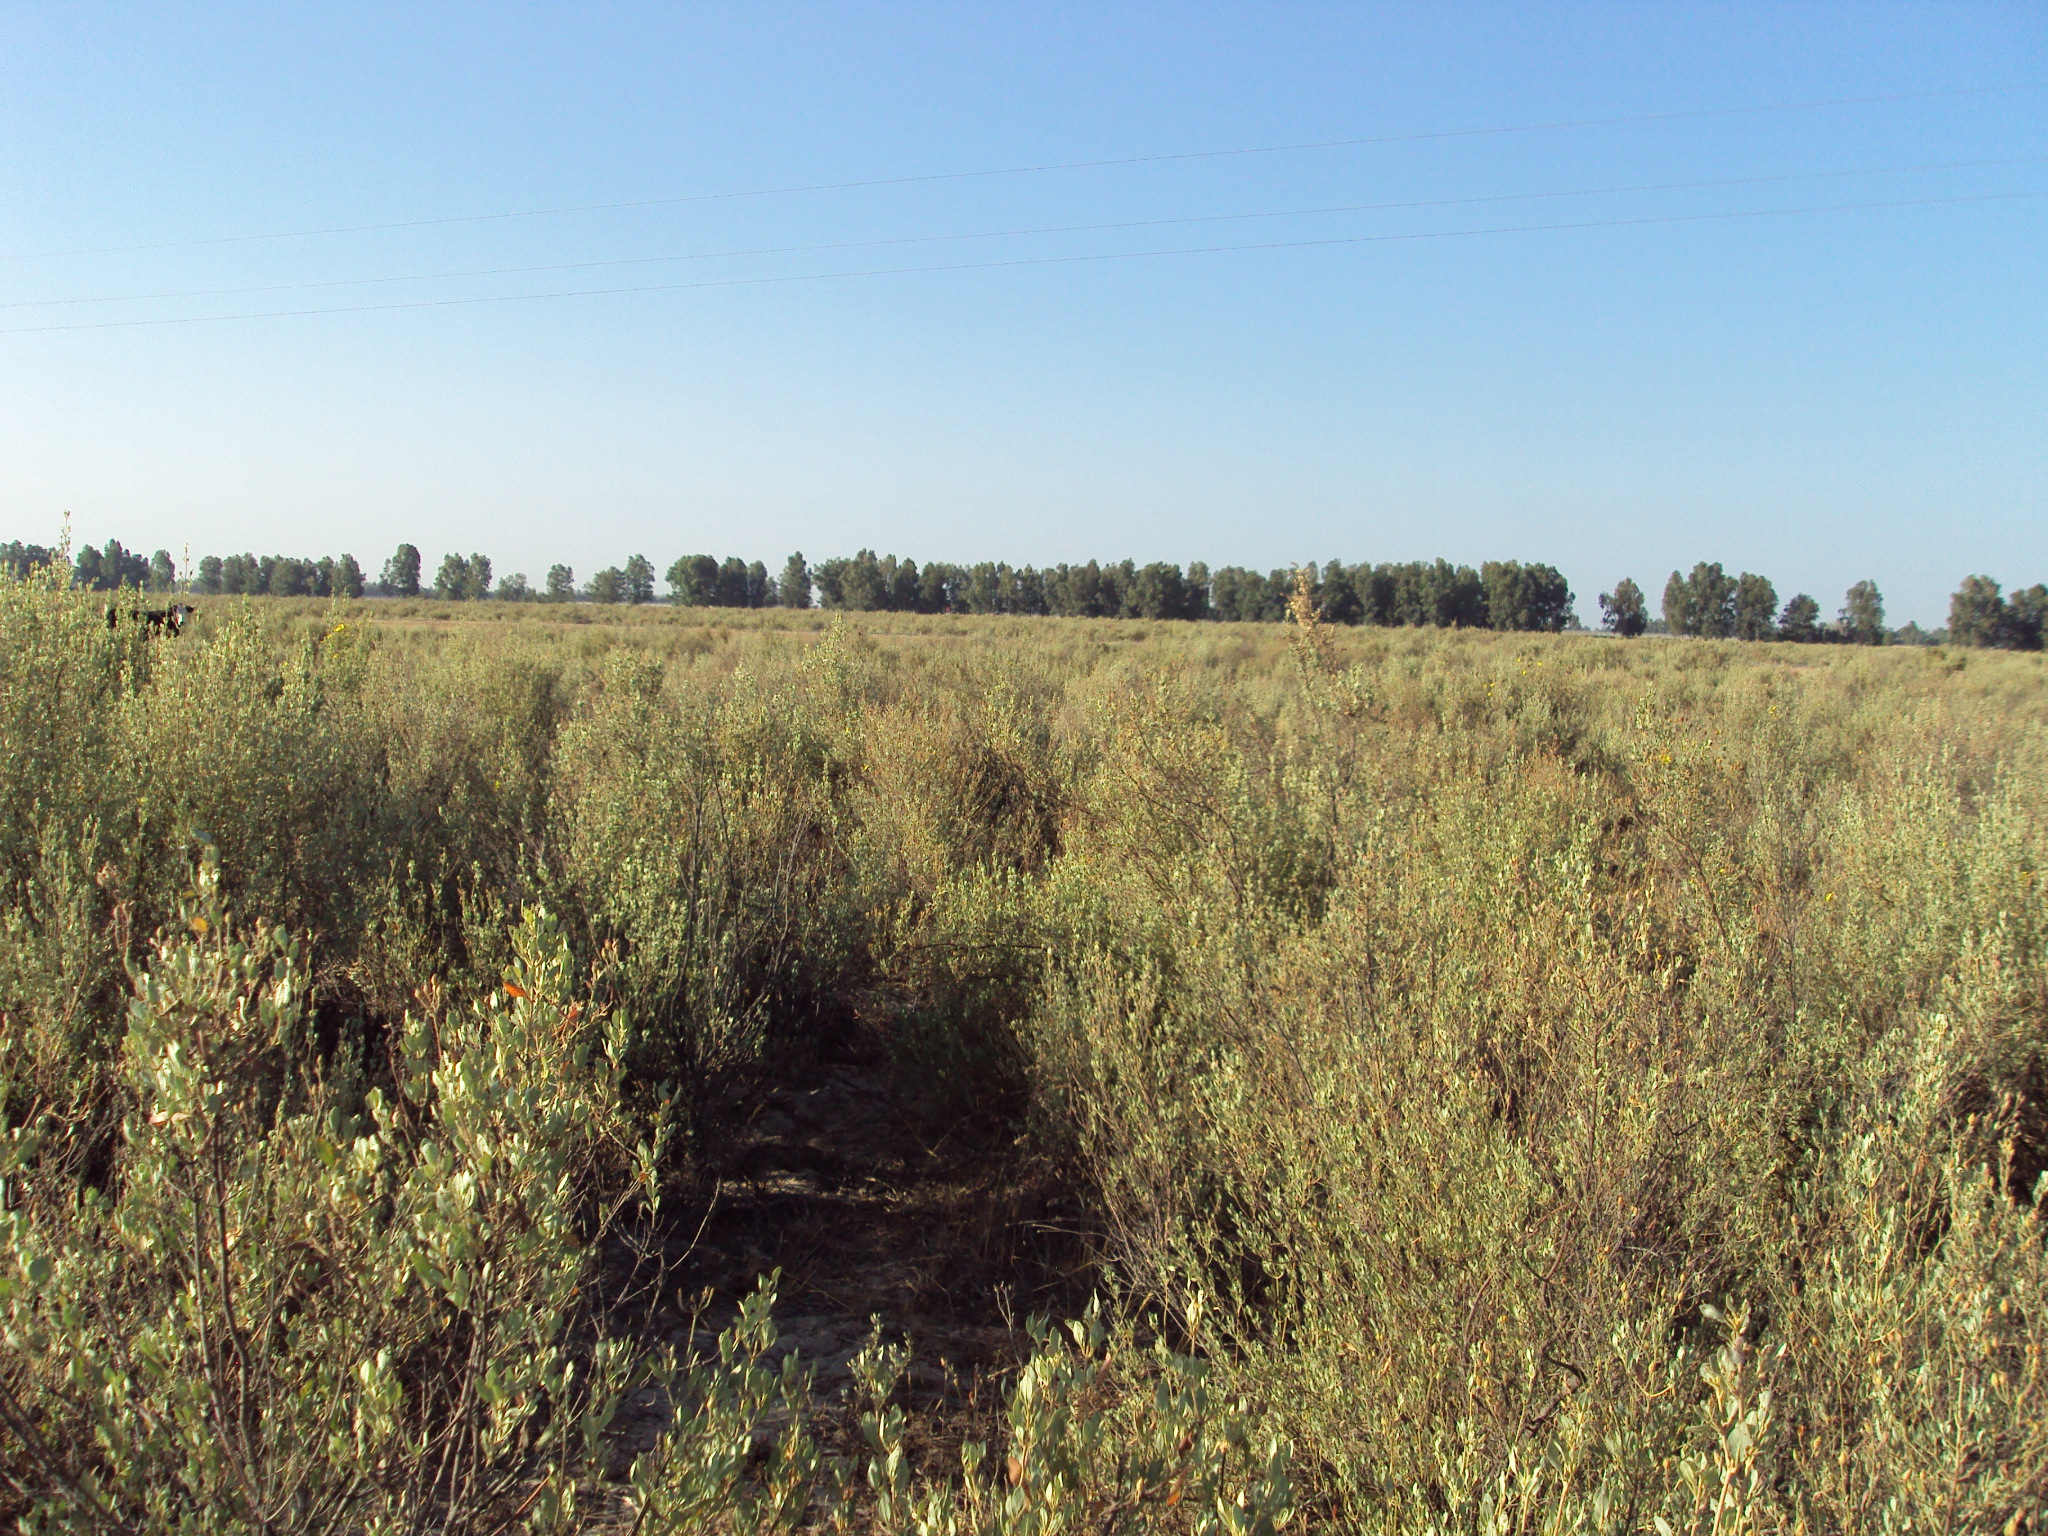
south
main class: Shrubland
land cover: Shrubland without tree cover
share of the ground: > 75 %
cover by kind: shrubs 80 %, herbaceous plants 20 %
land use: Agriculture (excluding fallow land and kitchen gardens)
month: July
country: ES
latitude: 37.0977
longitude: -6.5560
